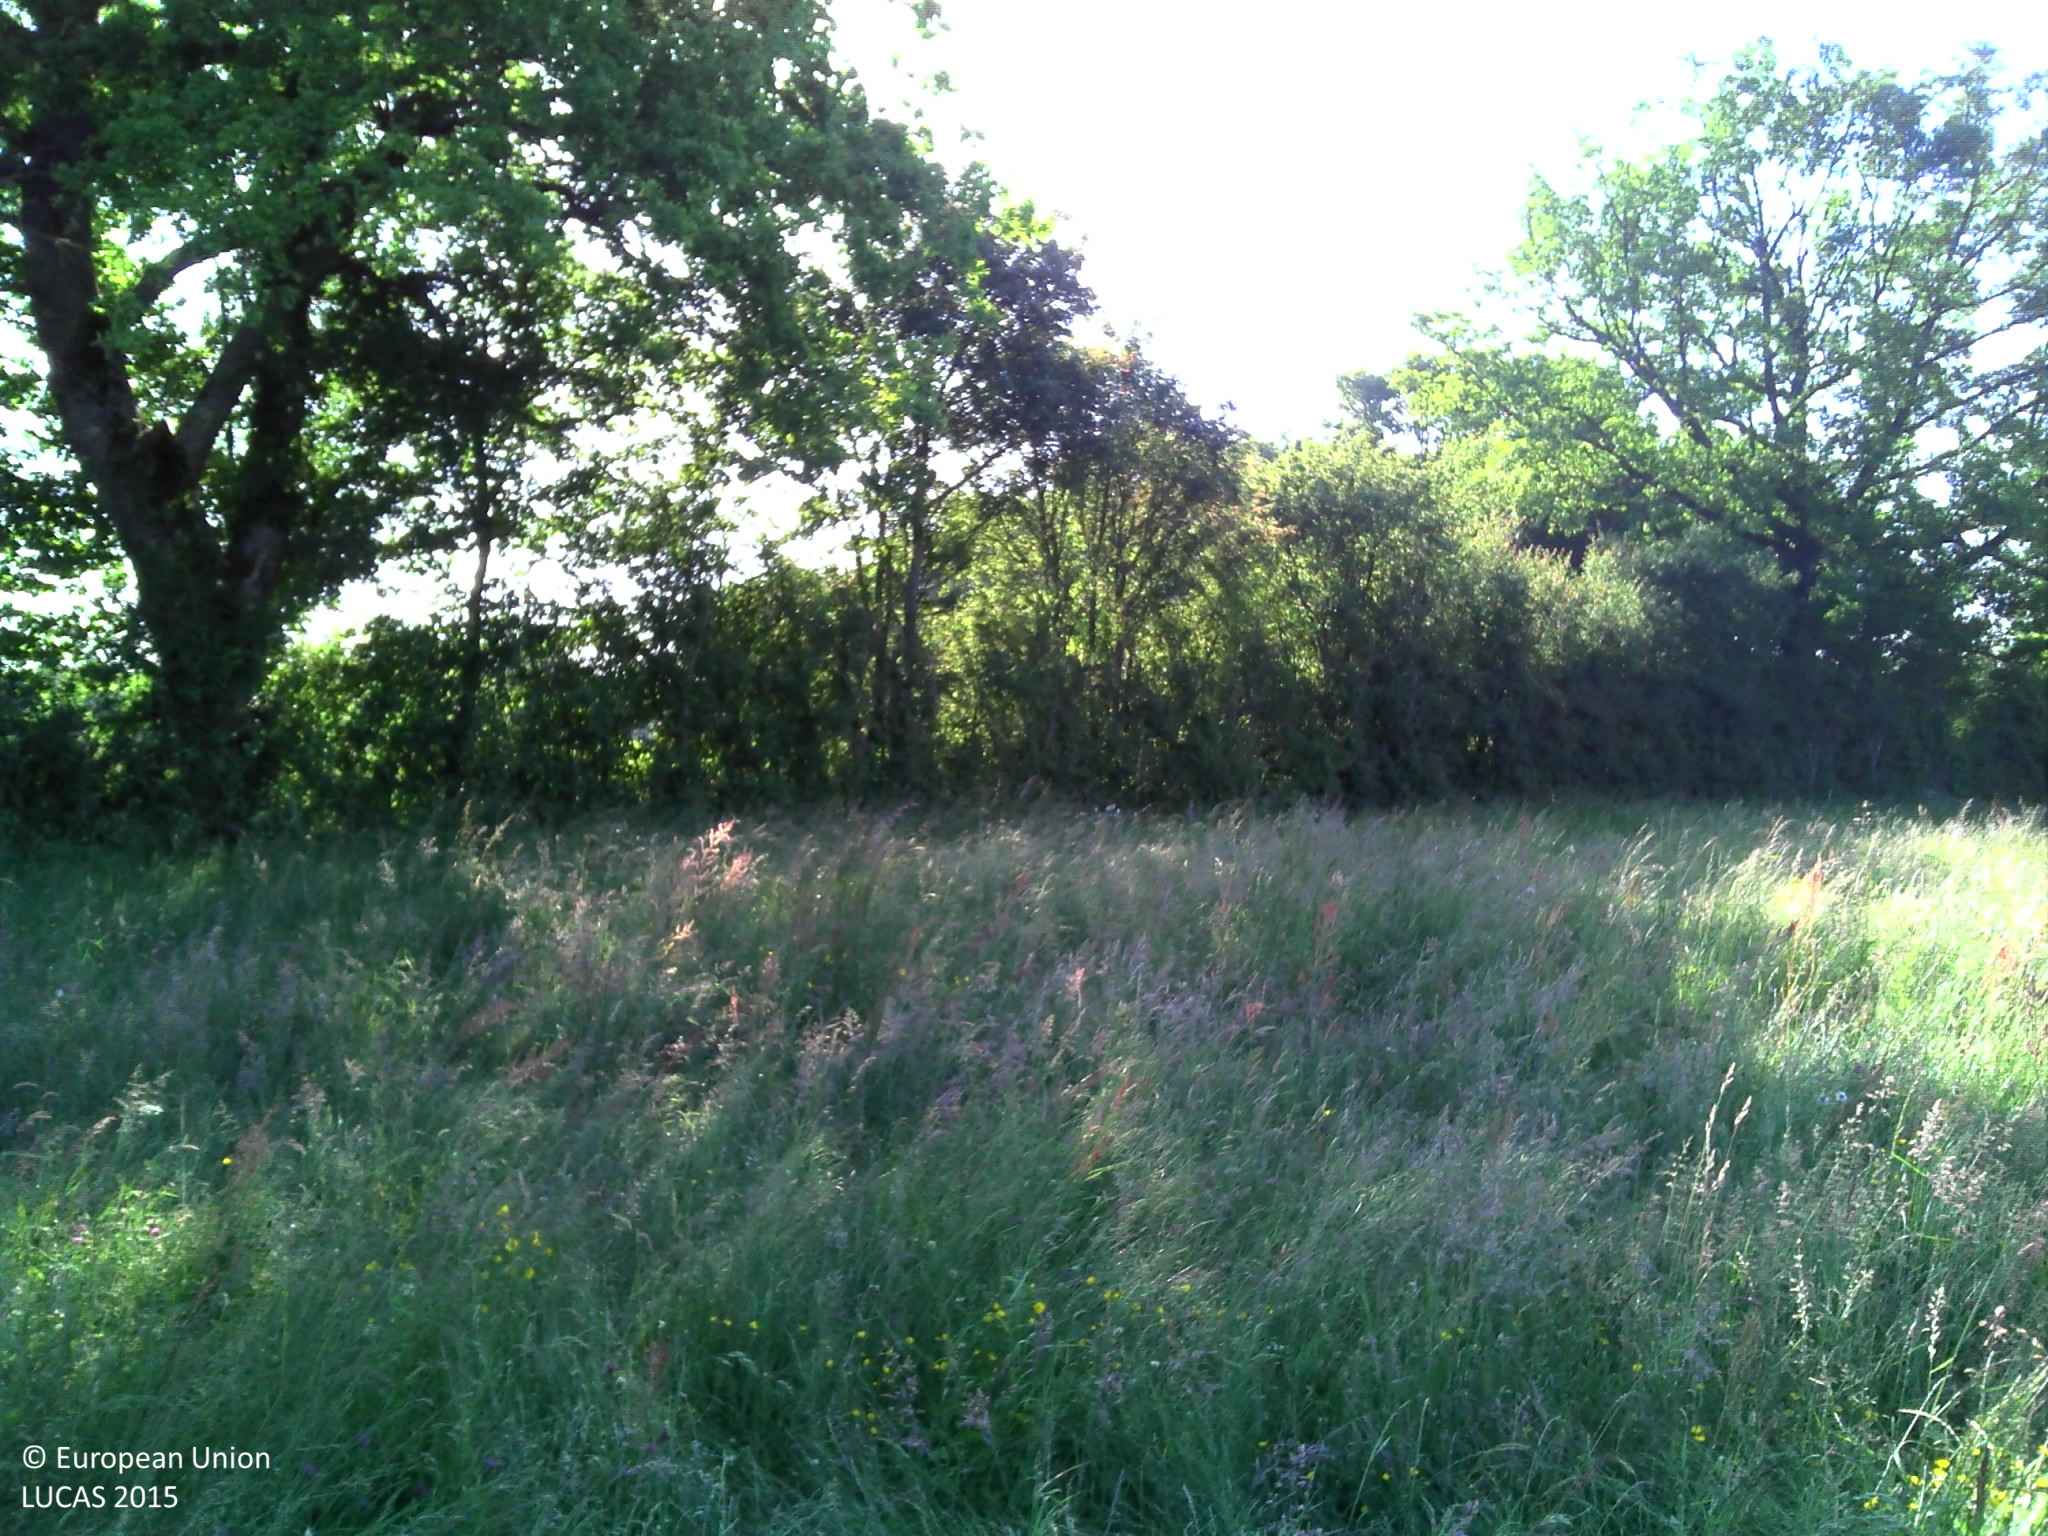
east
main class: Grassland
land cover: Grassland with sparse tree/shrub cover
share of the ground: > 75 %
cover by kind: herbaceous plants 95 %, broadleaved forest trees 5 %
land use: Agriculture (excluding fallow land and kitchen gardens)
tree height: > 5 m
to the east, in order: Grassland with sparse tree/shrub cover; Fences; Abandoned hedges; Tracks; Ditches and canals; Abandoned hedges; Mixed cereals for fodder; Fences; Broadleaved woodland; Fences; Mixed cereals for fodder; Broadleaved woodland
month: May
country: FR
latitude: 47.4328
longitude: 2.8742
